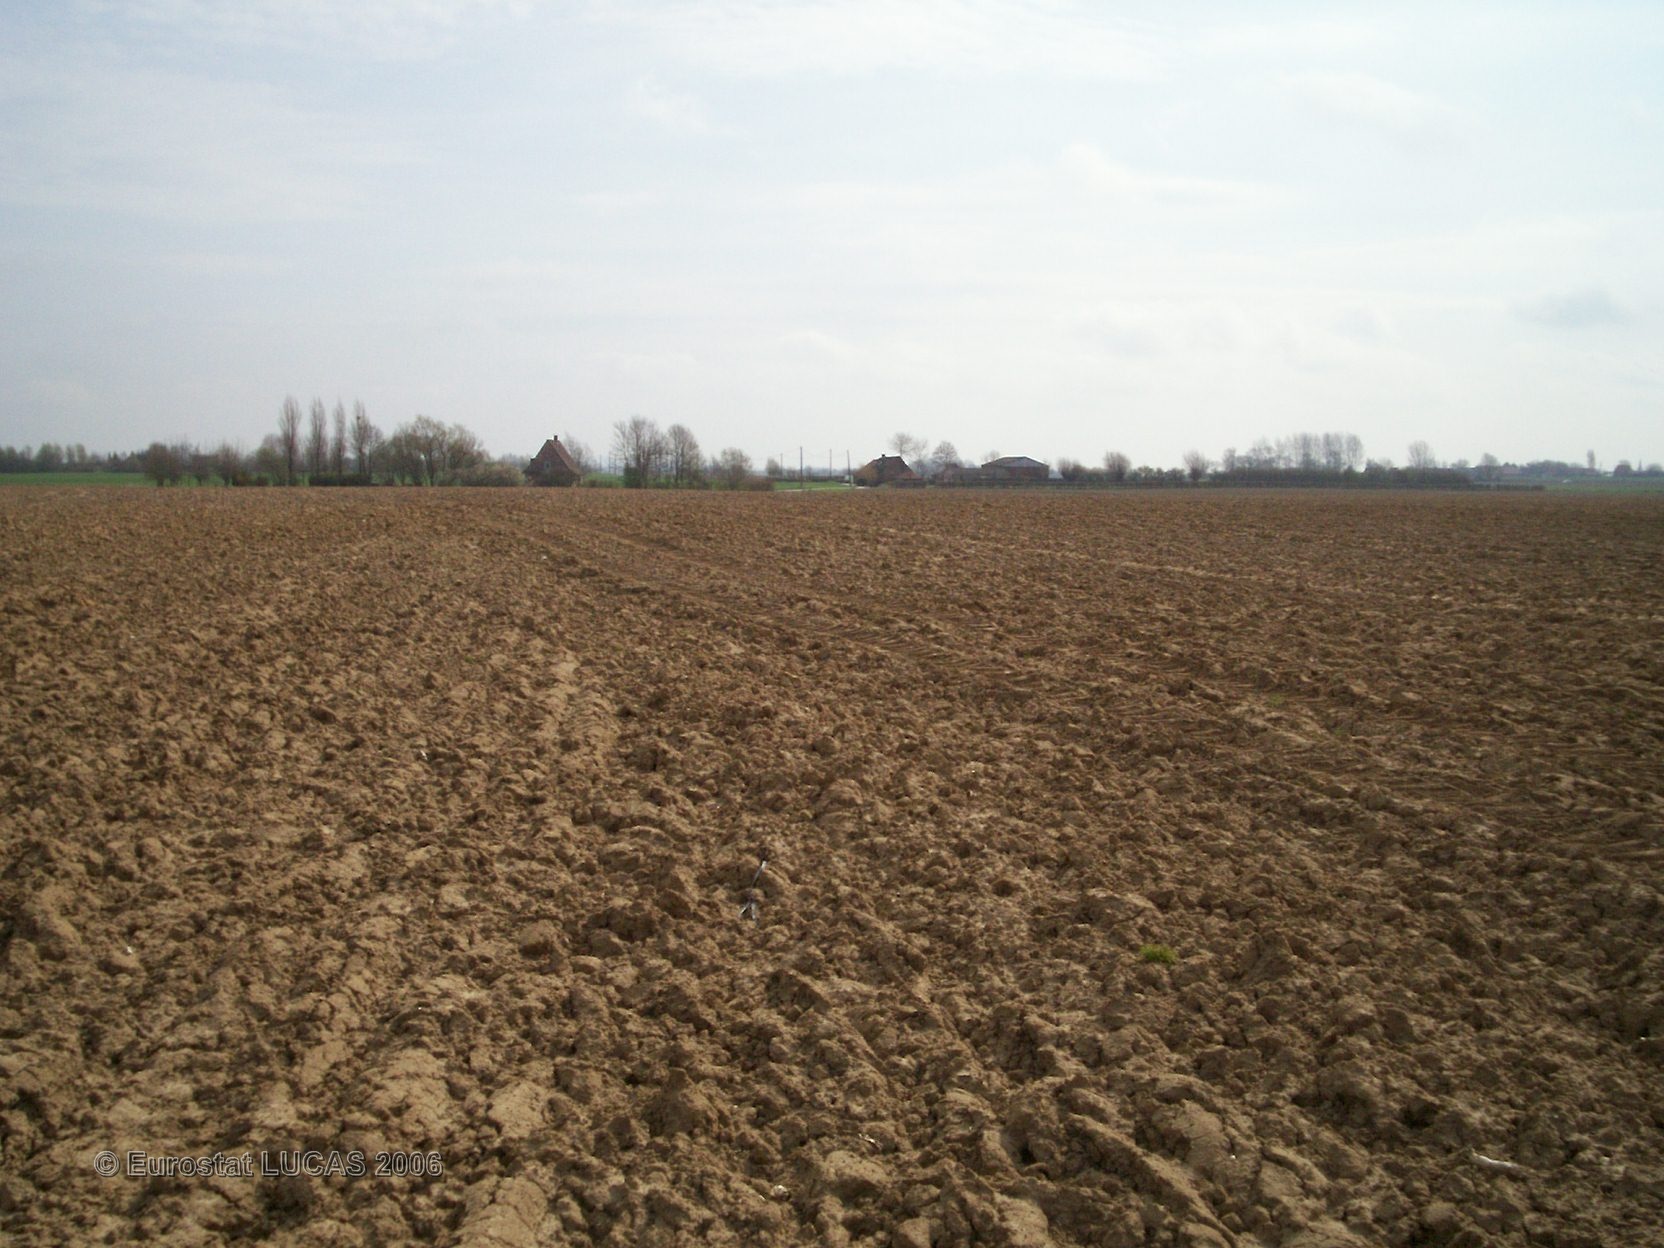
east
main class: Cropland
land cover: Potatoes
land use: Agriculture (excluding fallow land and kitchen gardens)
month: May
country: FR
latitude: 50.7669
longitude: 2.4867
